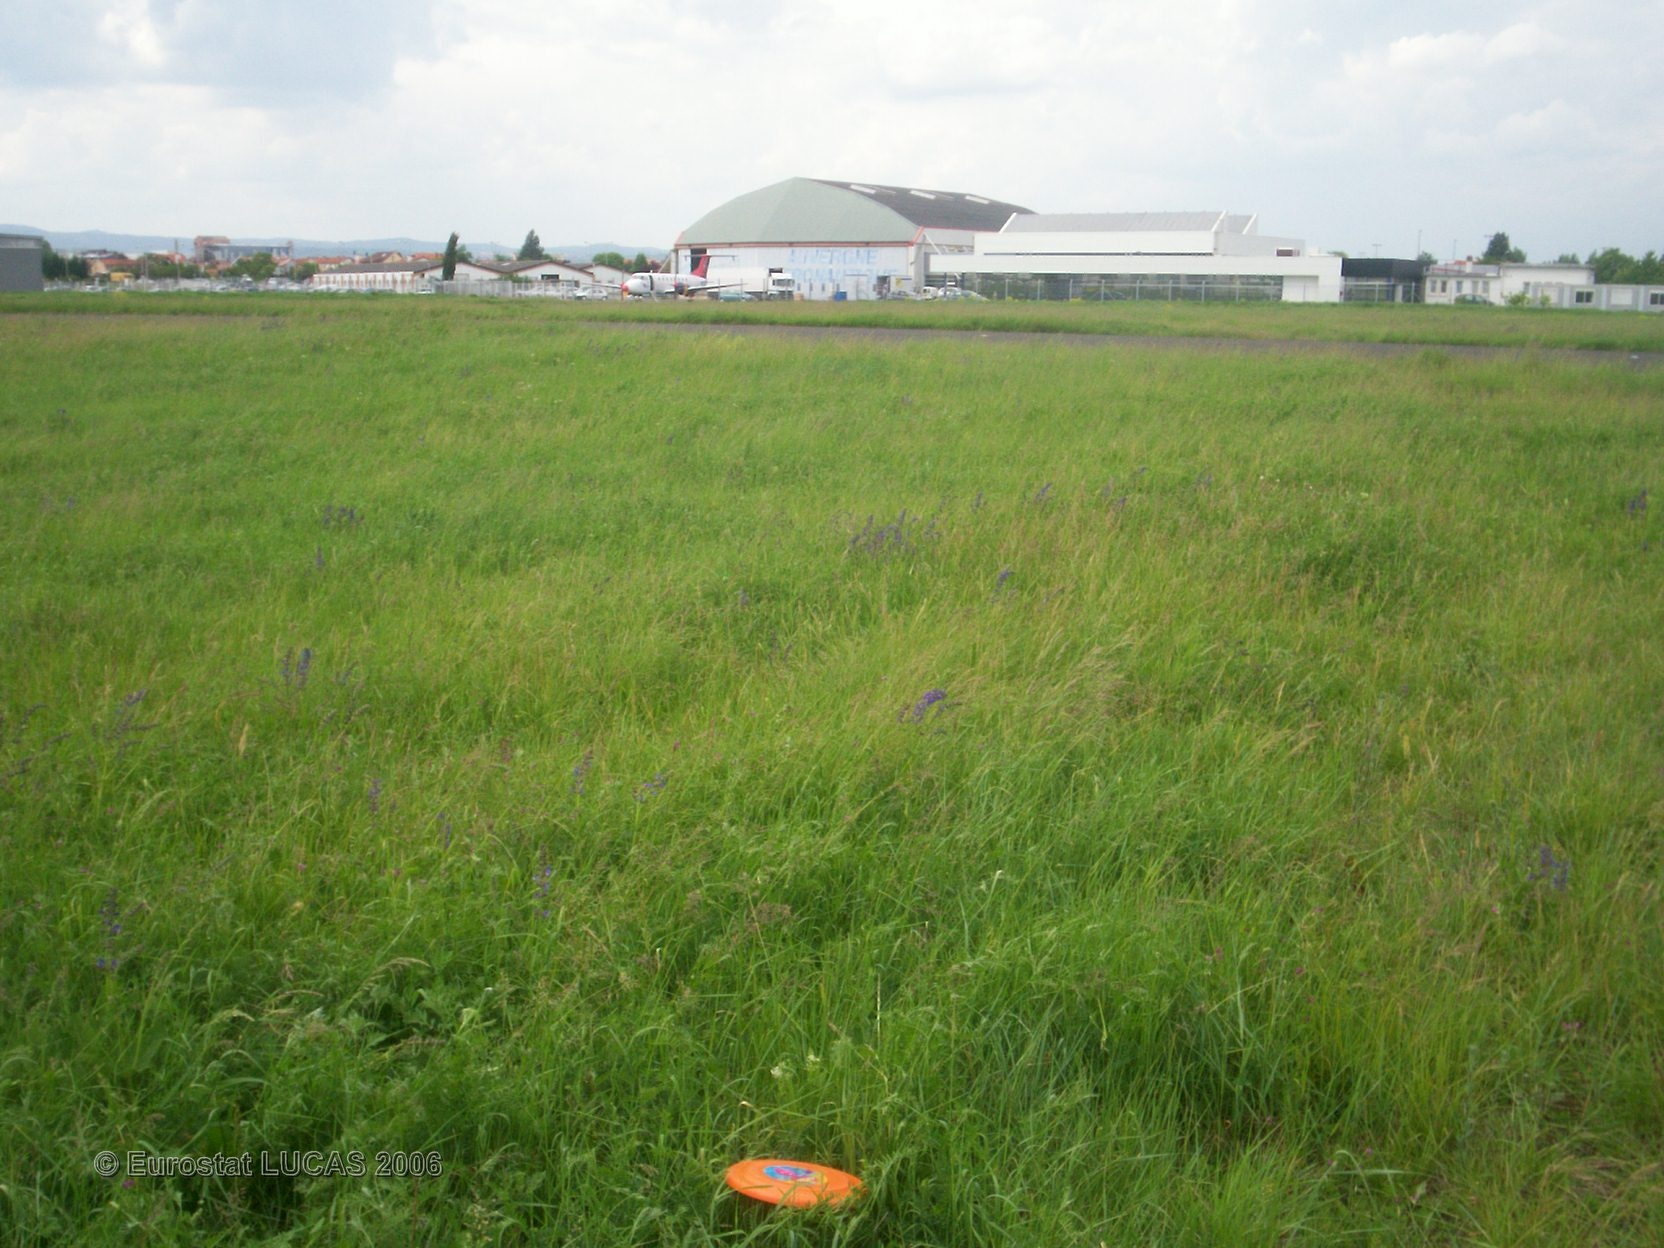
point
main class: Grassland
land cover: Grassland without tree/shrub cover
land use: Air transport
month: May
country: FR
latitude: 45.7893
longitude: 3.1693
